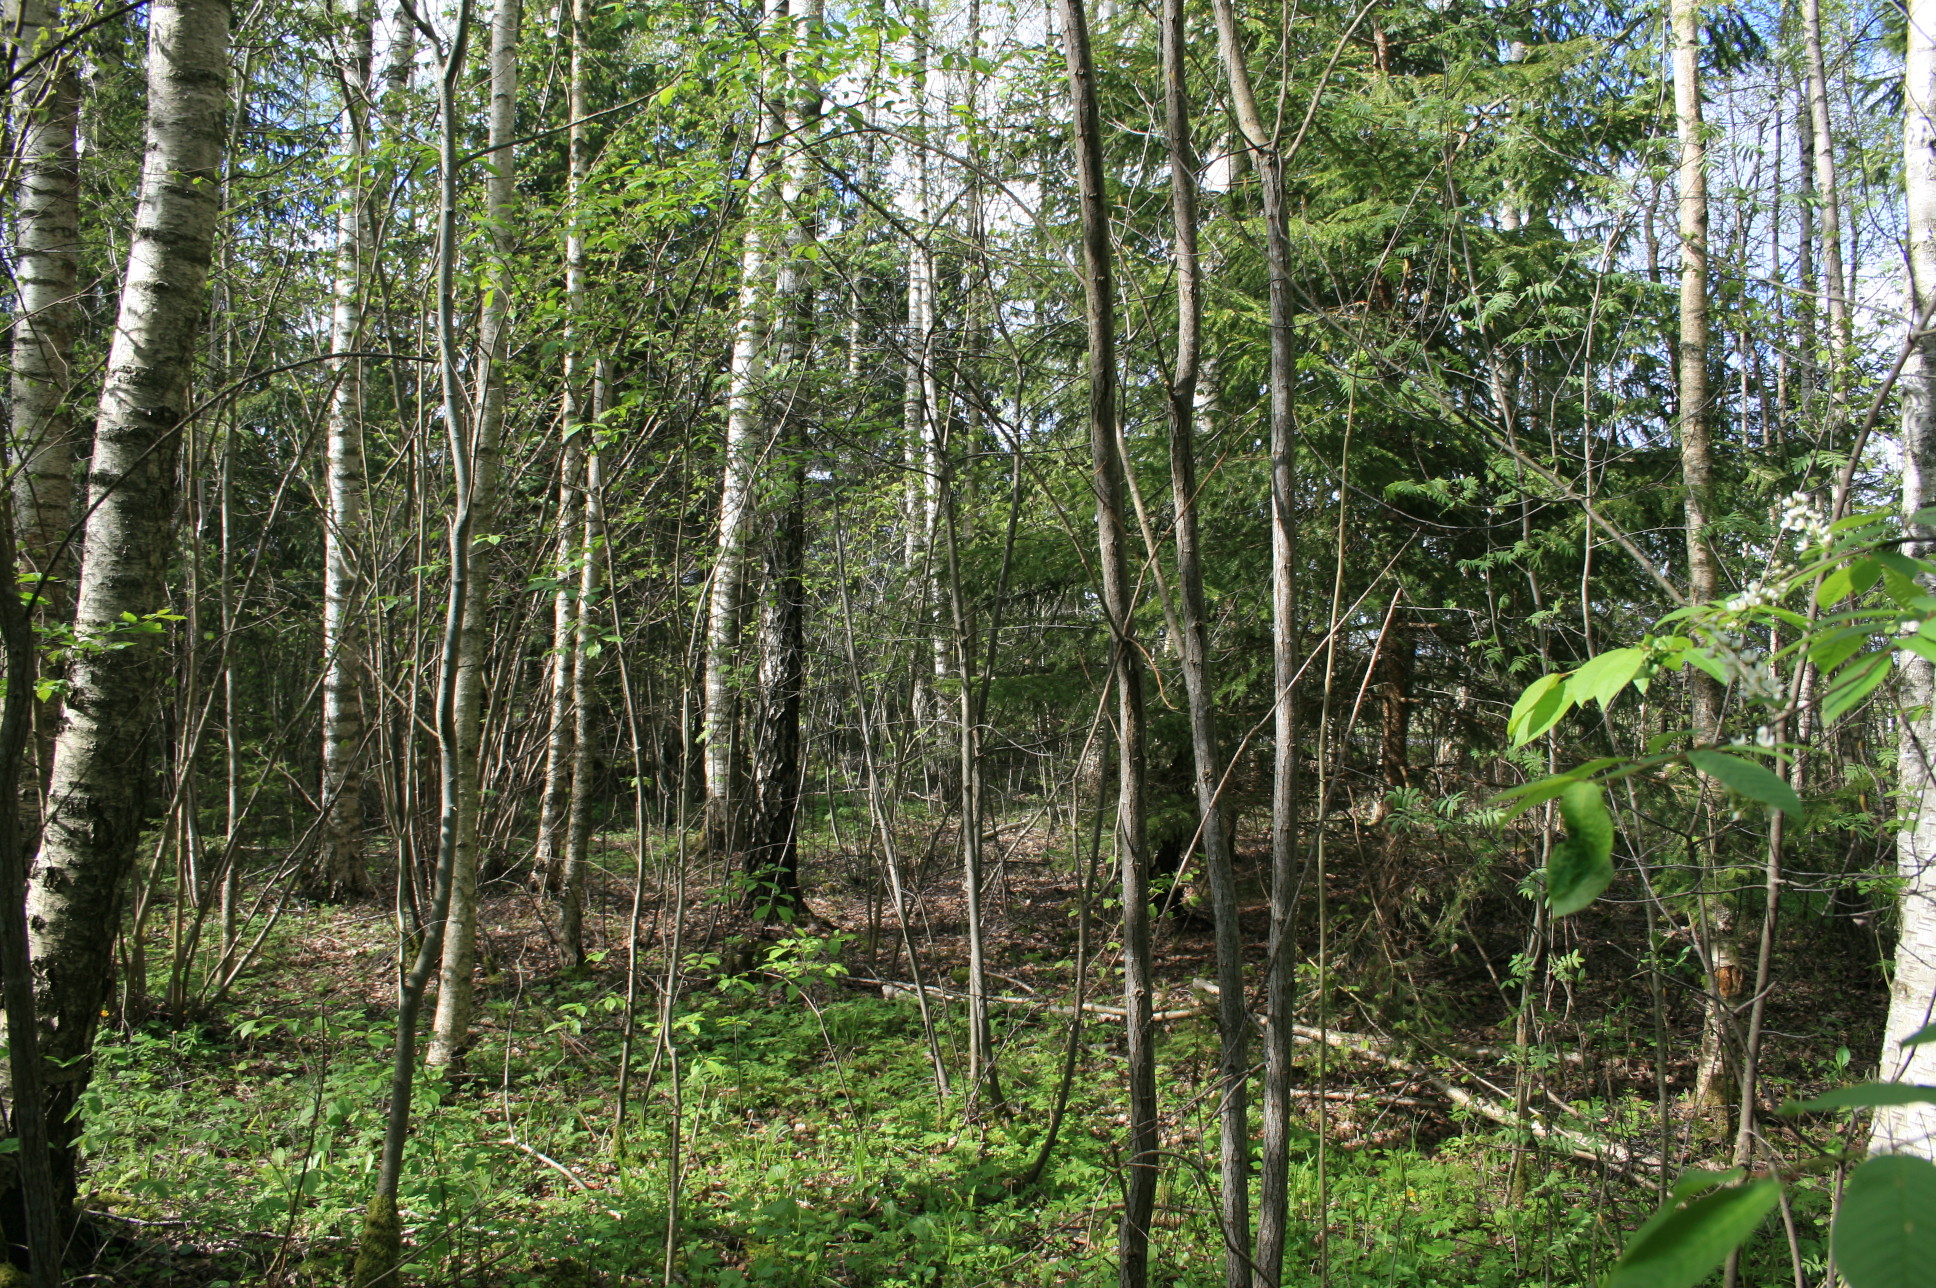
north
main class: Woodland
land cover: Other mixed woodland
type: hemiboreal forest and nemoral coniferous forest and mixed broadleaved-coniferous forest
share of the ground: > 75 %
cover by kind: broadleaved forest trees 60 %, coniferous forest trees 35 %, herbaceous plants 5 %
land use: Forestry
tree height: > 5 m
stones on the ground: < 10 %
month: May
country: LT
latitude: 56.2250
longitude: 21.3801
